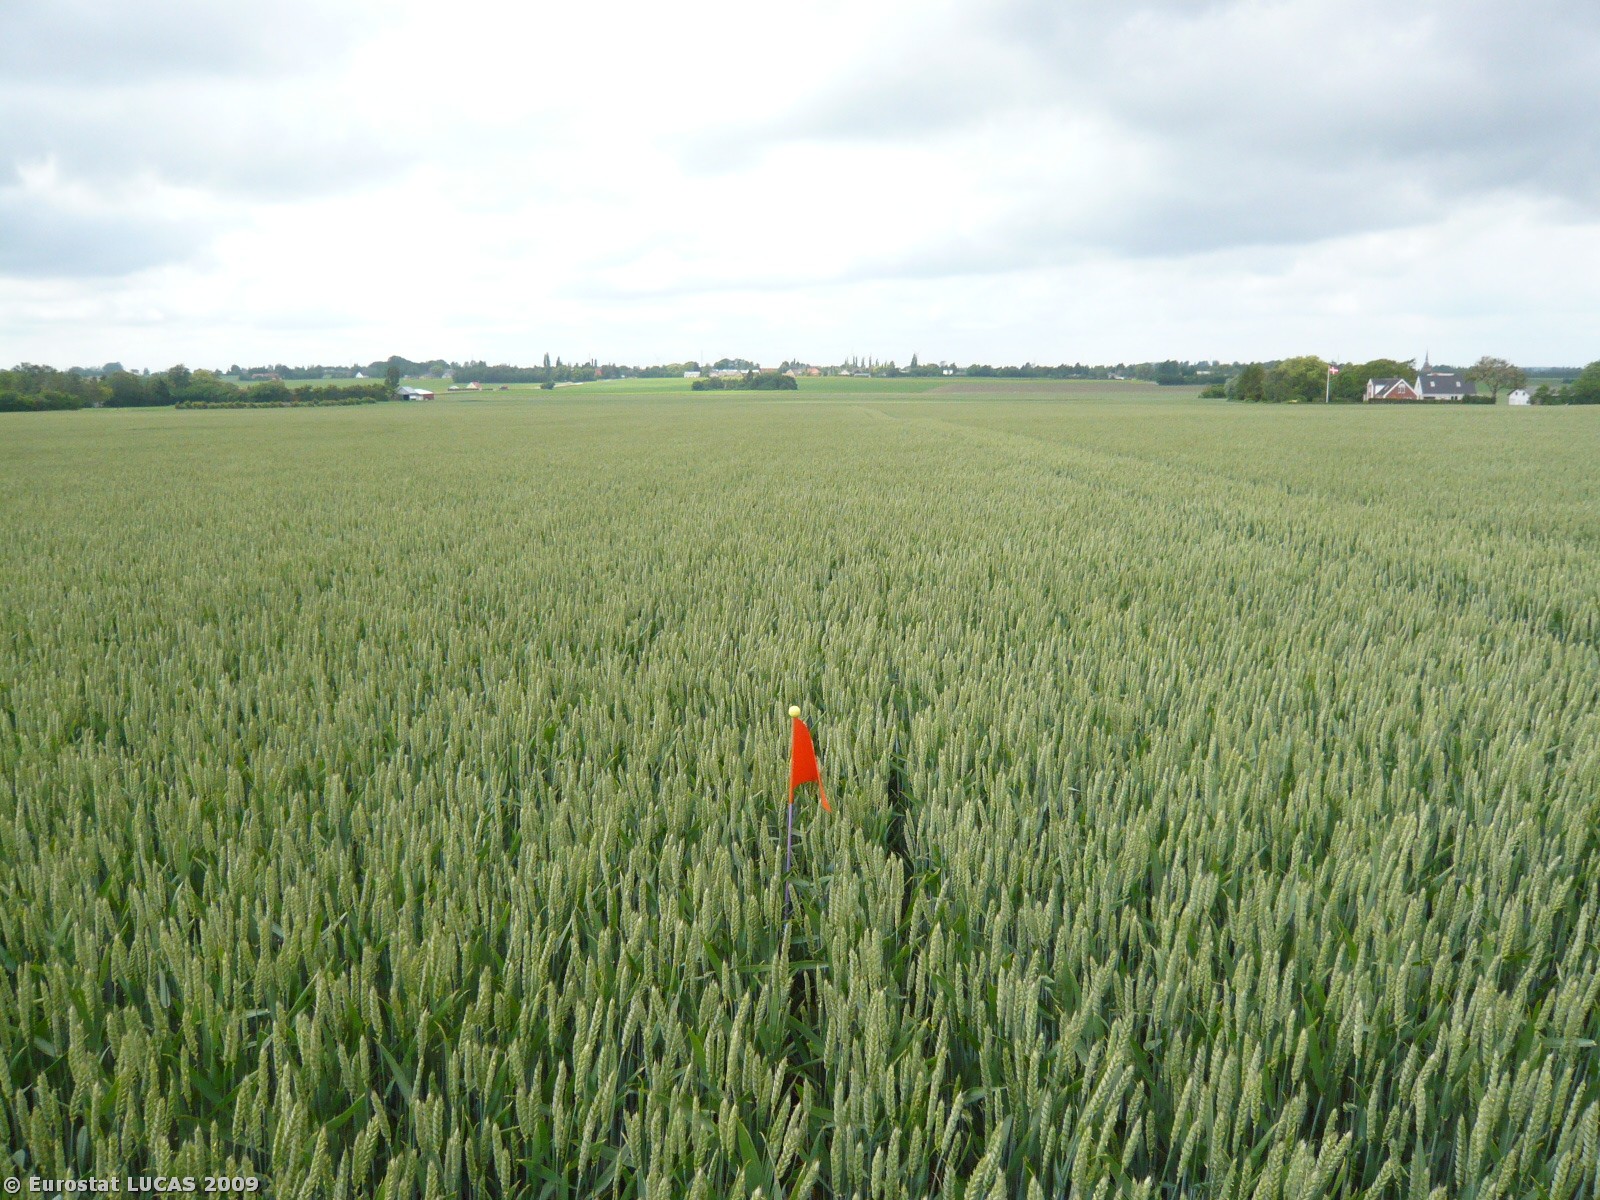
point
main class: Cropland
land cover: Common wheat
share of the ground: > 75 %
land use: Agriculture (excluding fallow land and kitchen gardens)
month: June
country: DK
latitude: 54.8983
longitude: 11.8232
